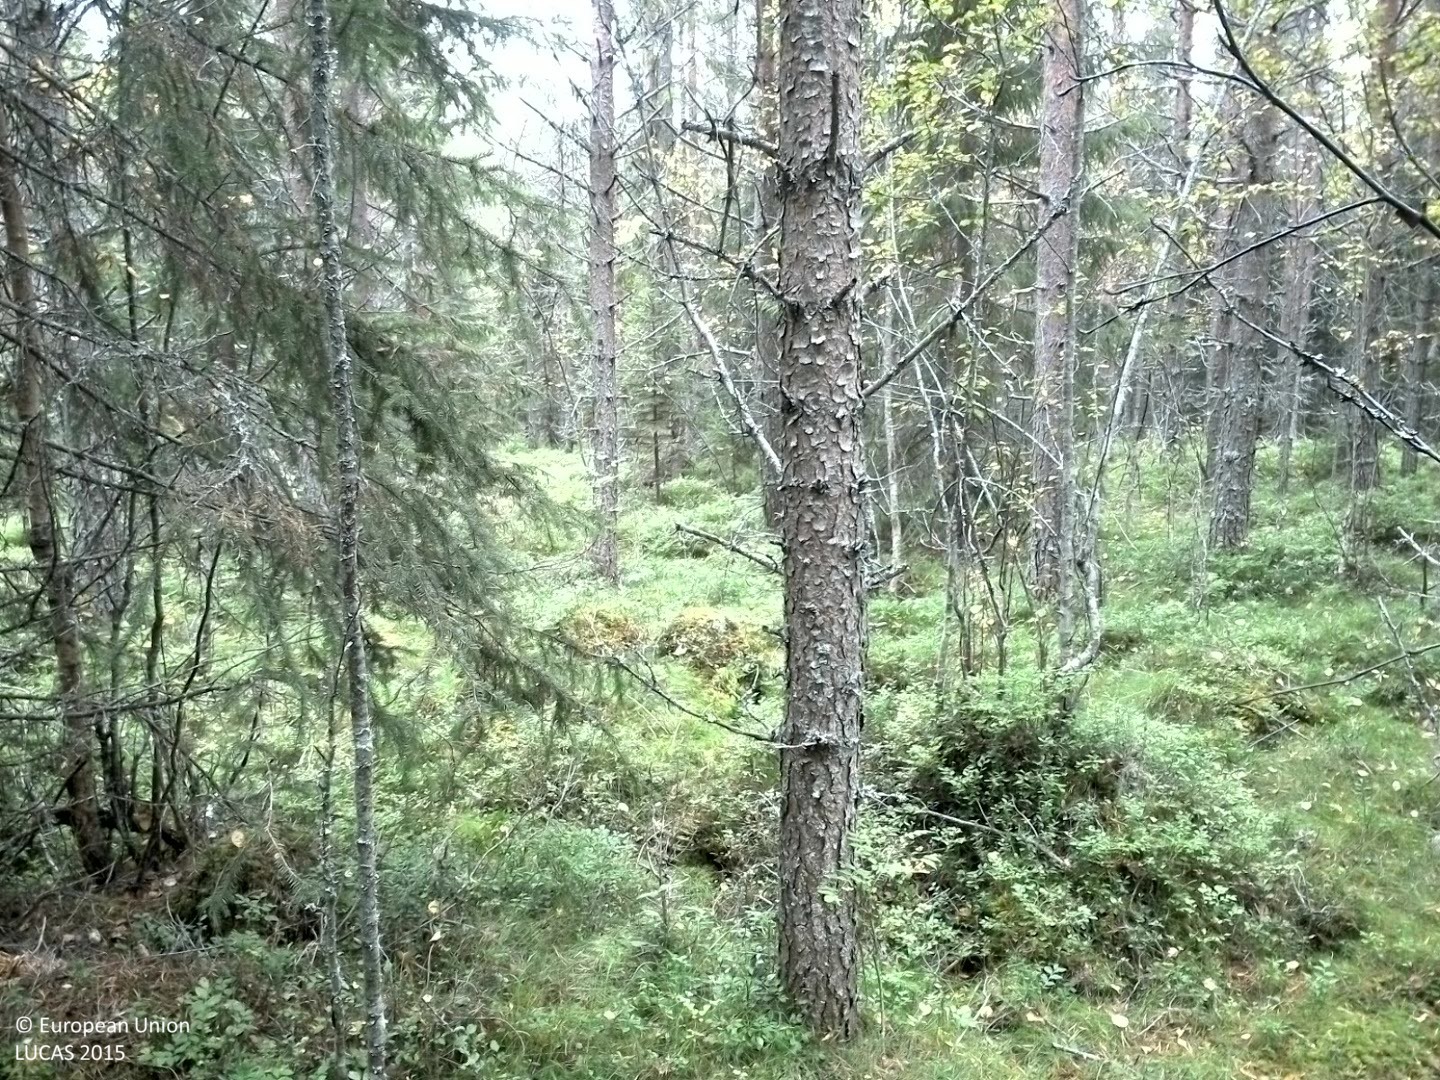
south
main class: Woodland
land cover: Other mixed woodland
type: boreal forest
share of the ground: 50 - 75 %
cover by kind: coniferous forest trees 45 %, herbaceous plants 25 %, broadleaved forest trees 20 %, shrubs 10 %
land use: Forestry
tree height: > 5 m
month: September
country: SE
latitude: 62.3082
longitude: 15.6321
